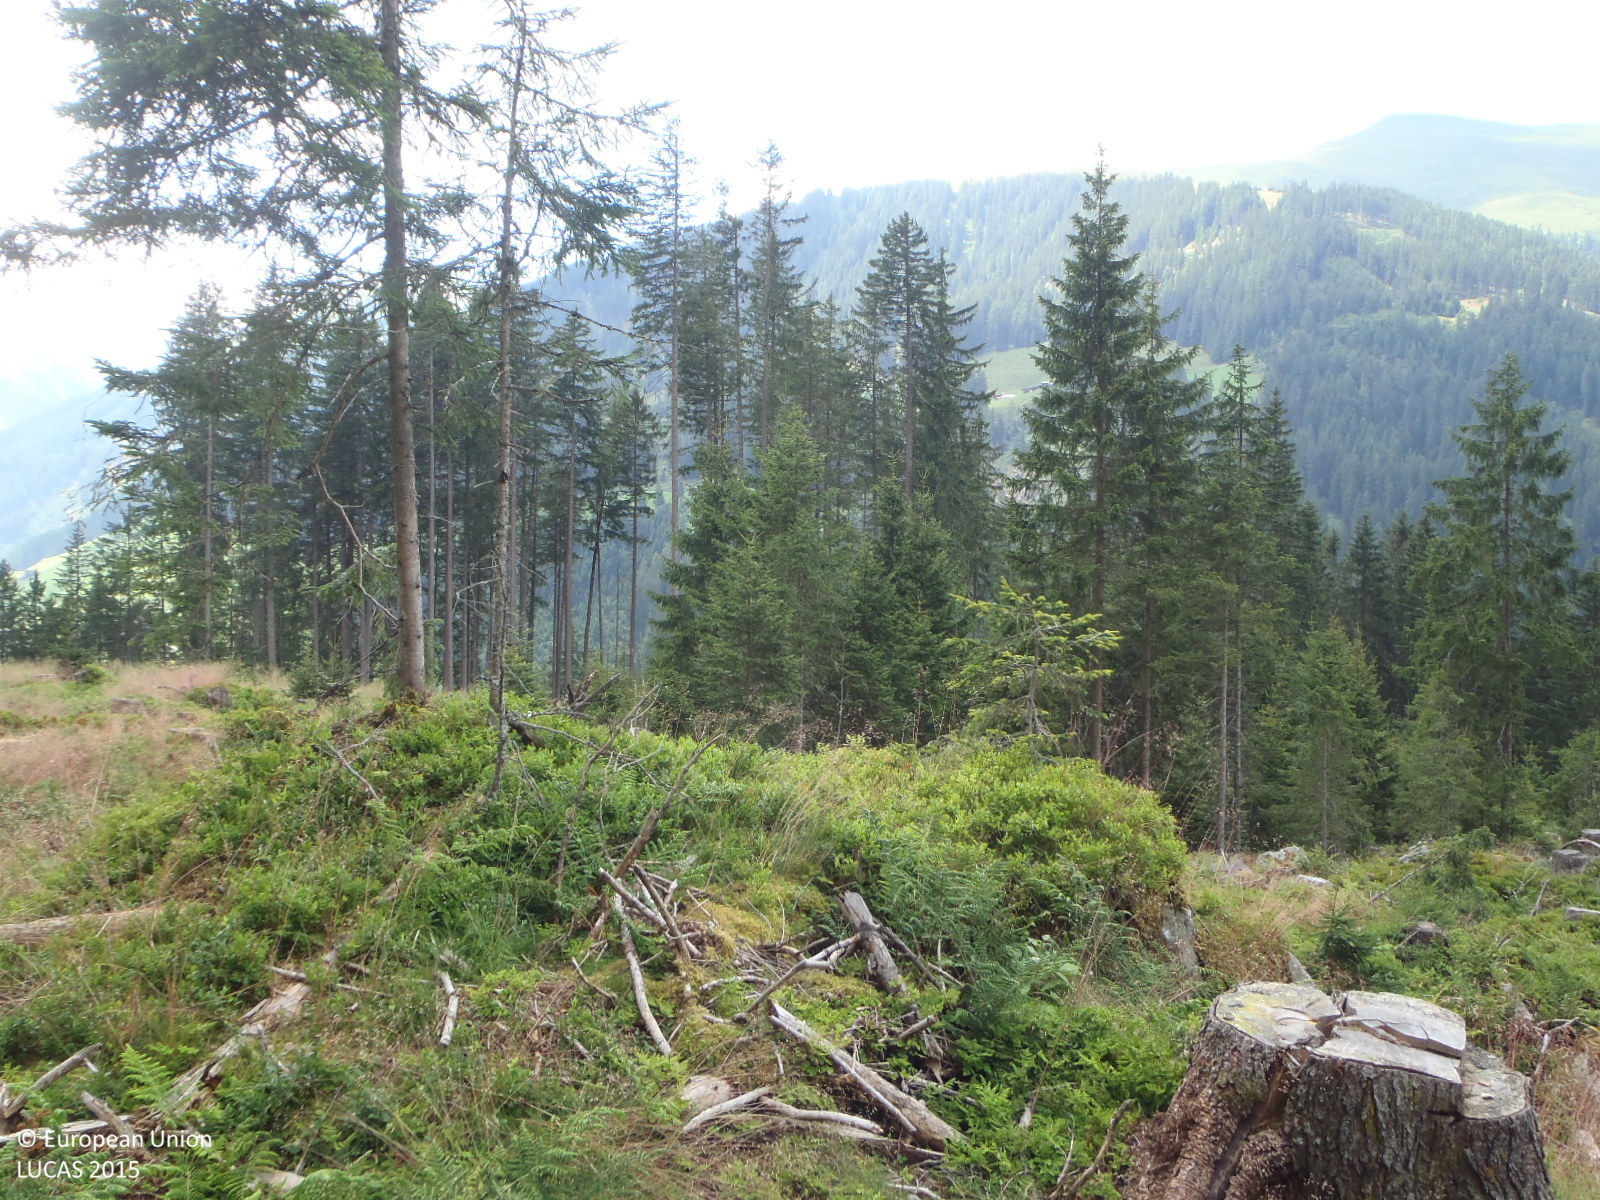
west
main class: Woodland
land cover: Spruce dominated coniferous woodland
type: alpine coniferous forest
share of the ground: 10 - 25 %
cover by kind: herbaceous plants 70 %, coniferous forest trees 25 %, shrubs 5 %
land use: Forestry
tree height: < 5 m
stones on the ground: < 10 %
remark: Clear cut
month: July
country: AT
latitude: 47.1478
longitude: 11.7260
